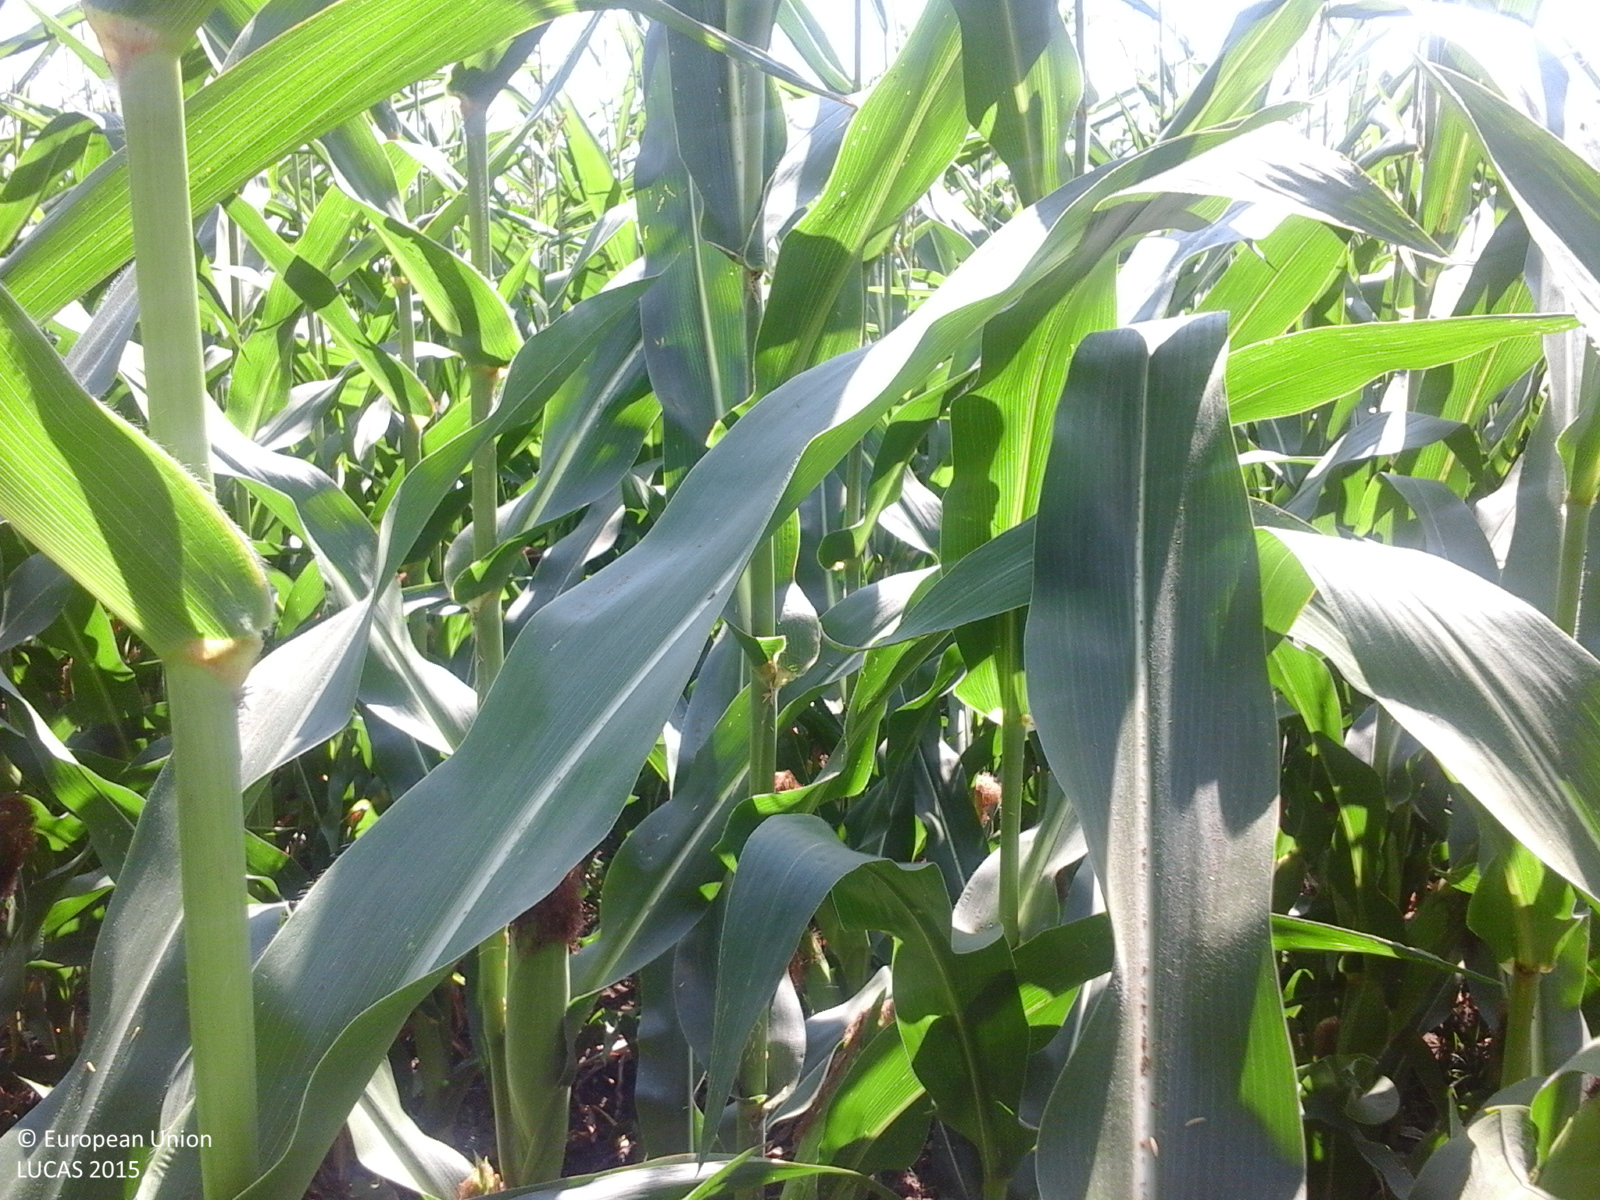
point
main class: Cropland
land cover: Maize
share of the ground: > 75 %
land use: Agriculture (excluding fallow land and kitchen gardens)
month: July
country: RO
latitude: 44.6592
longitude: 26.8102
